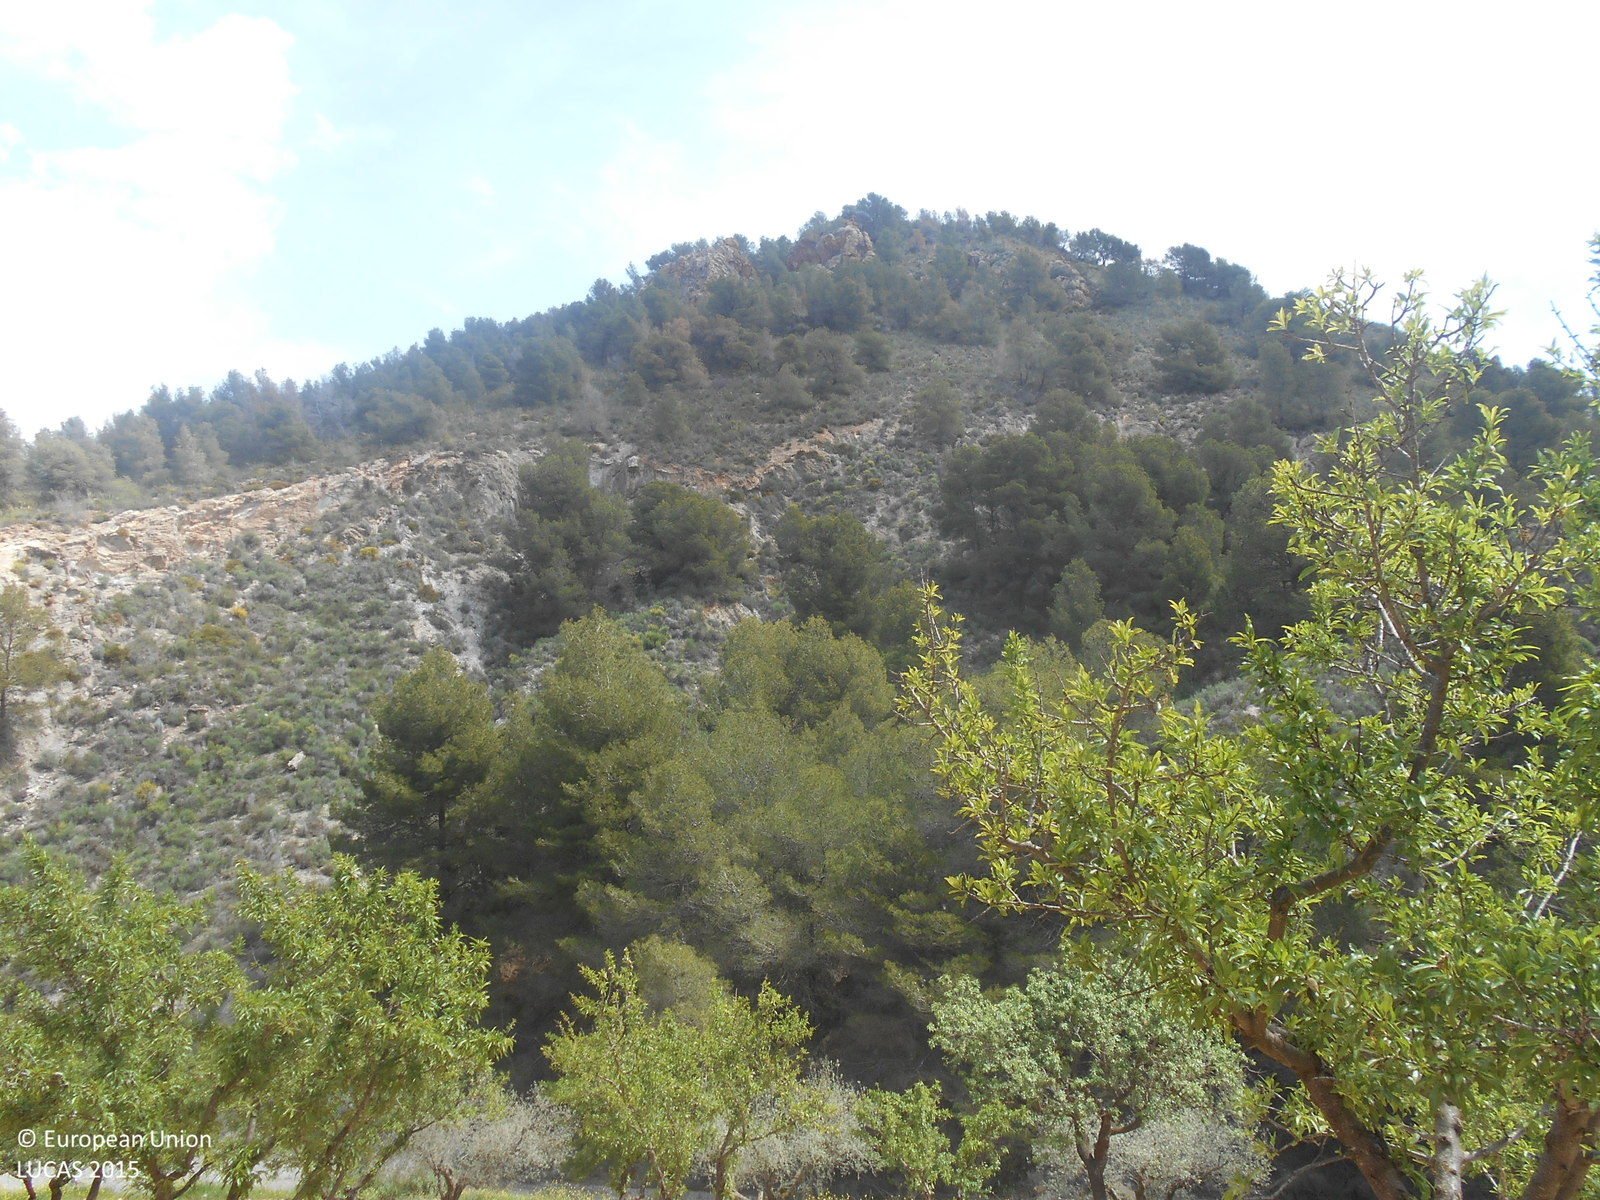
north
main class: Woodland
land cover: Pine dominated coniferous woodland
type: coniferous forest of the mediterranean region
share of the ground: > 75 %
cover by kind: coniferous forest trees 50 %, shrubs 40 %, unconsolidated bare surface 10 %
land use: Semi-natural and natural areas not in use
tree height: > 5 m
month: April
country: ES
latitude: 37.6296
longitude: -1.5276
